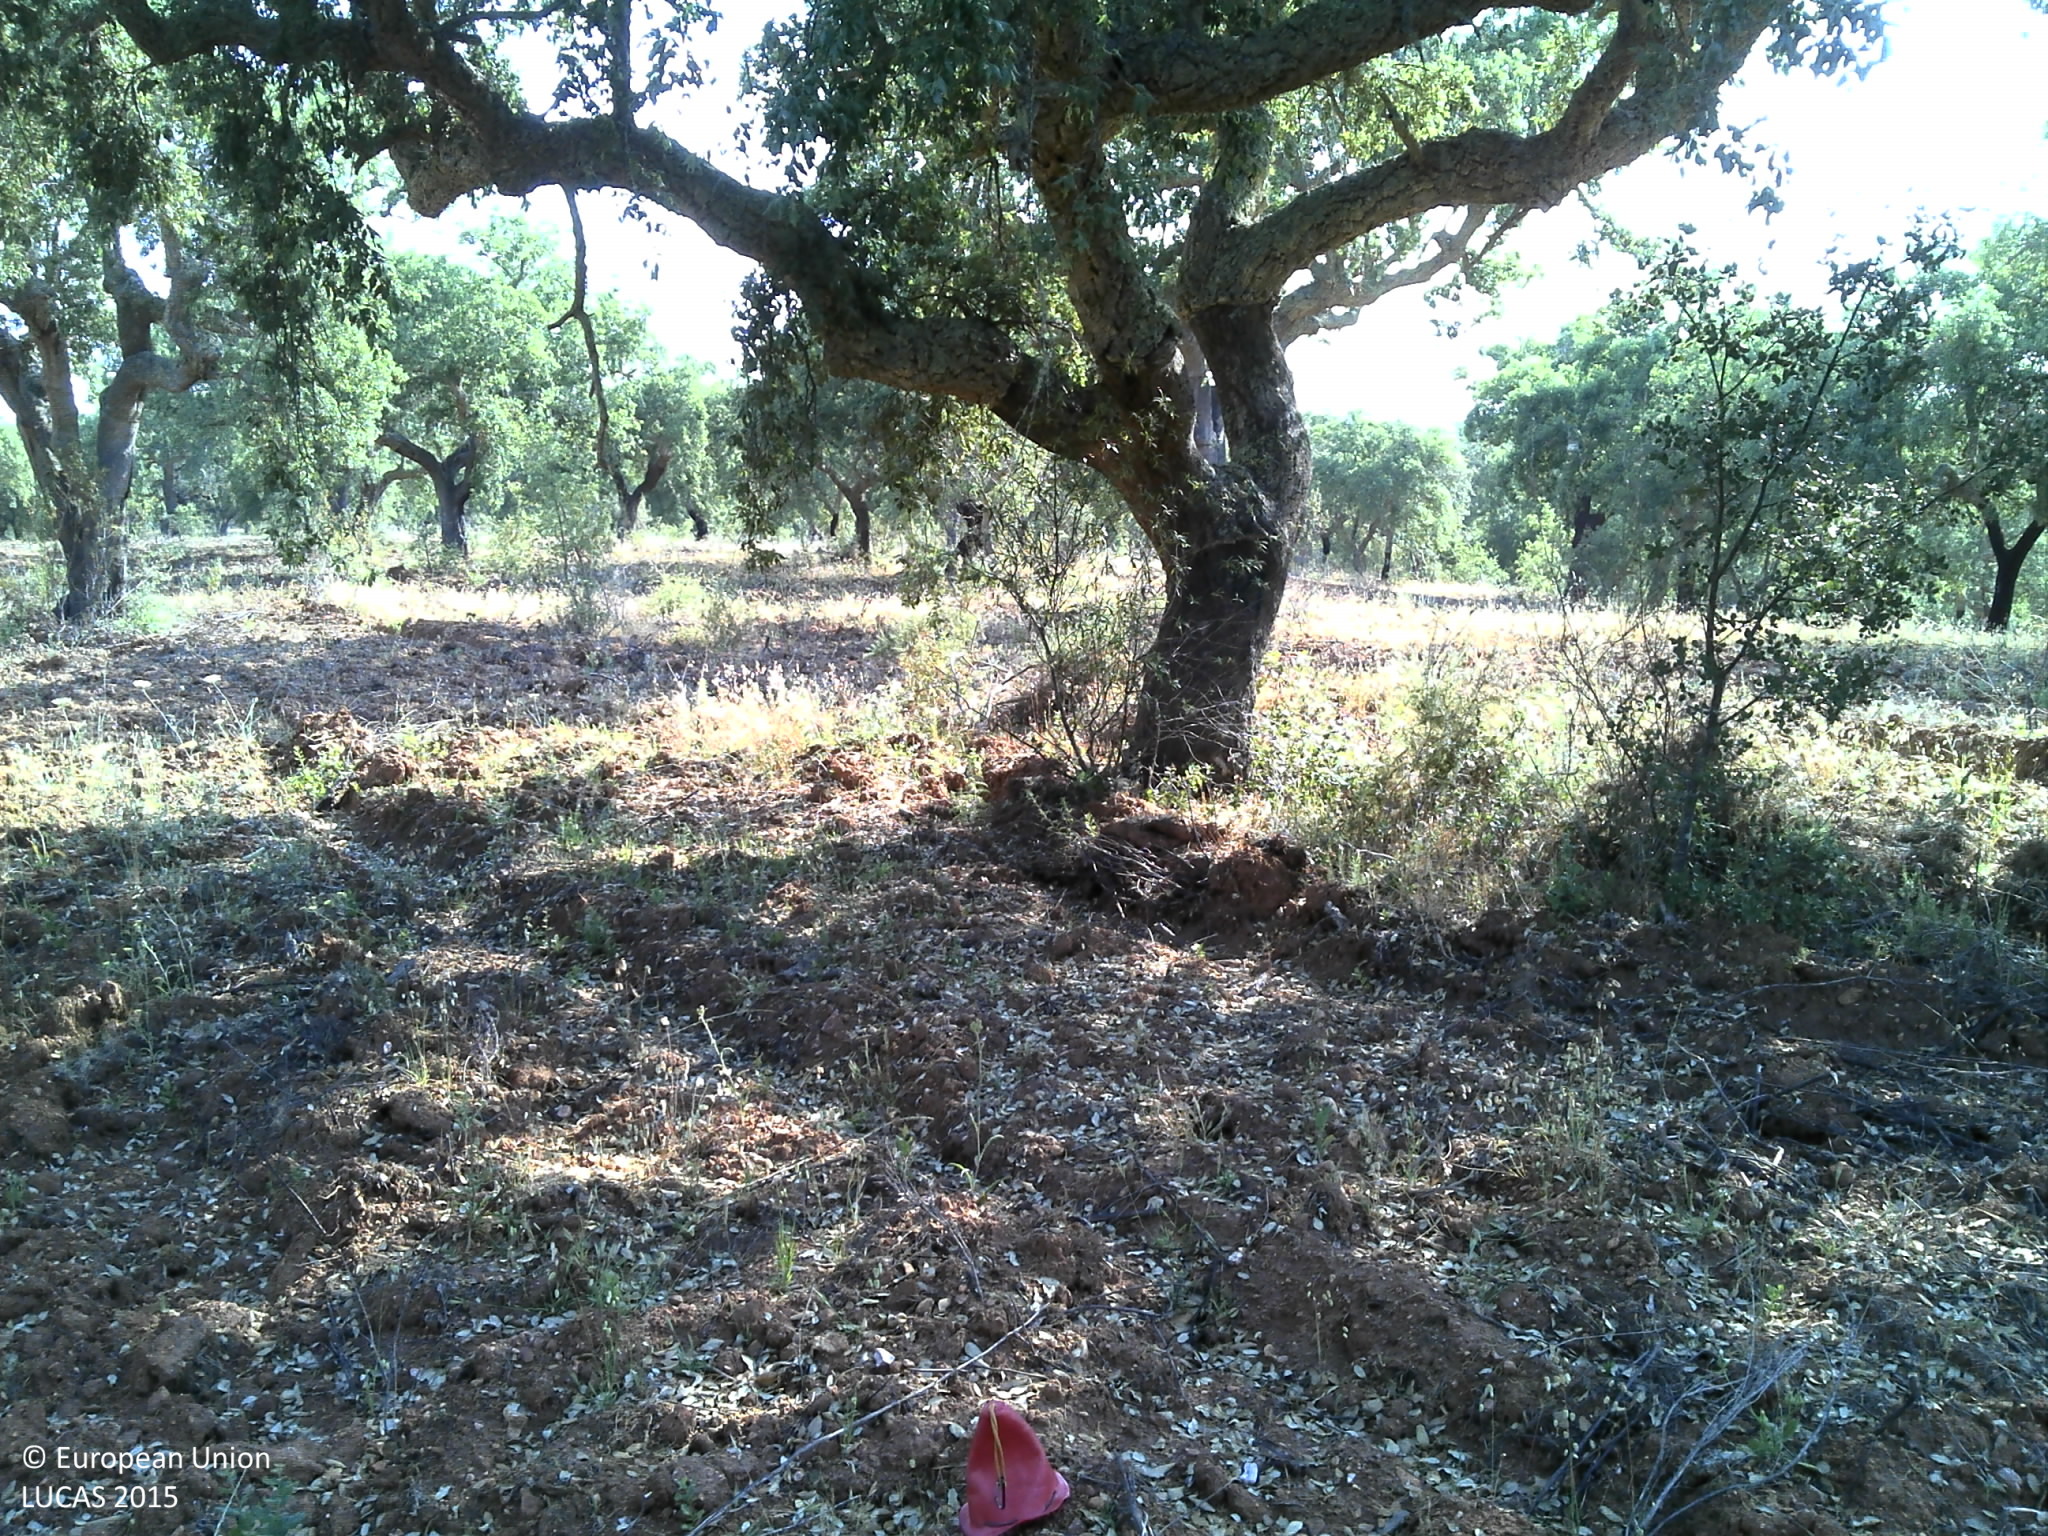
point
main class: Woodland
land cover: Broadleaved woodland
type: broadleaved evergreen forest
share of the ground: 50 - 75 %
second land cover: Spontaneously vegetated surfaces
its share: 10 - 25 %
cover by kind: broadleaved forest trees 60 %, unconsolidated bare surface 25 %, herbaceous plants 15 %
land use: Forestry
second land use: Agriculture (excluding fallow land and kitchen gardens)
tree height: > 5 m
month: May
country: PT
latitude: 38.8863
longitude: -7.7845
